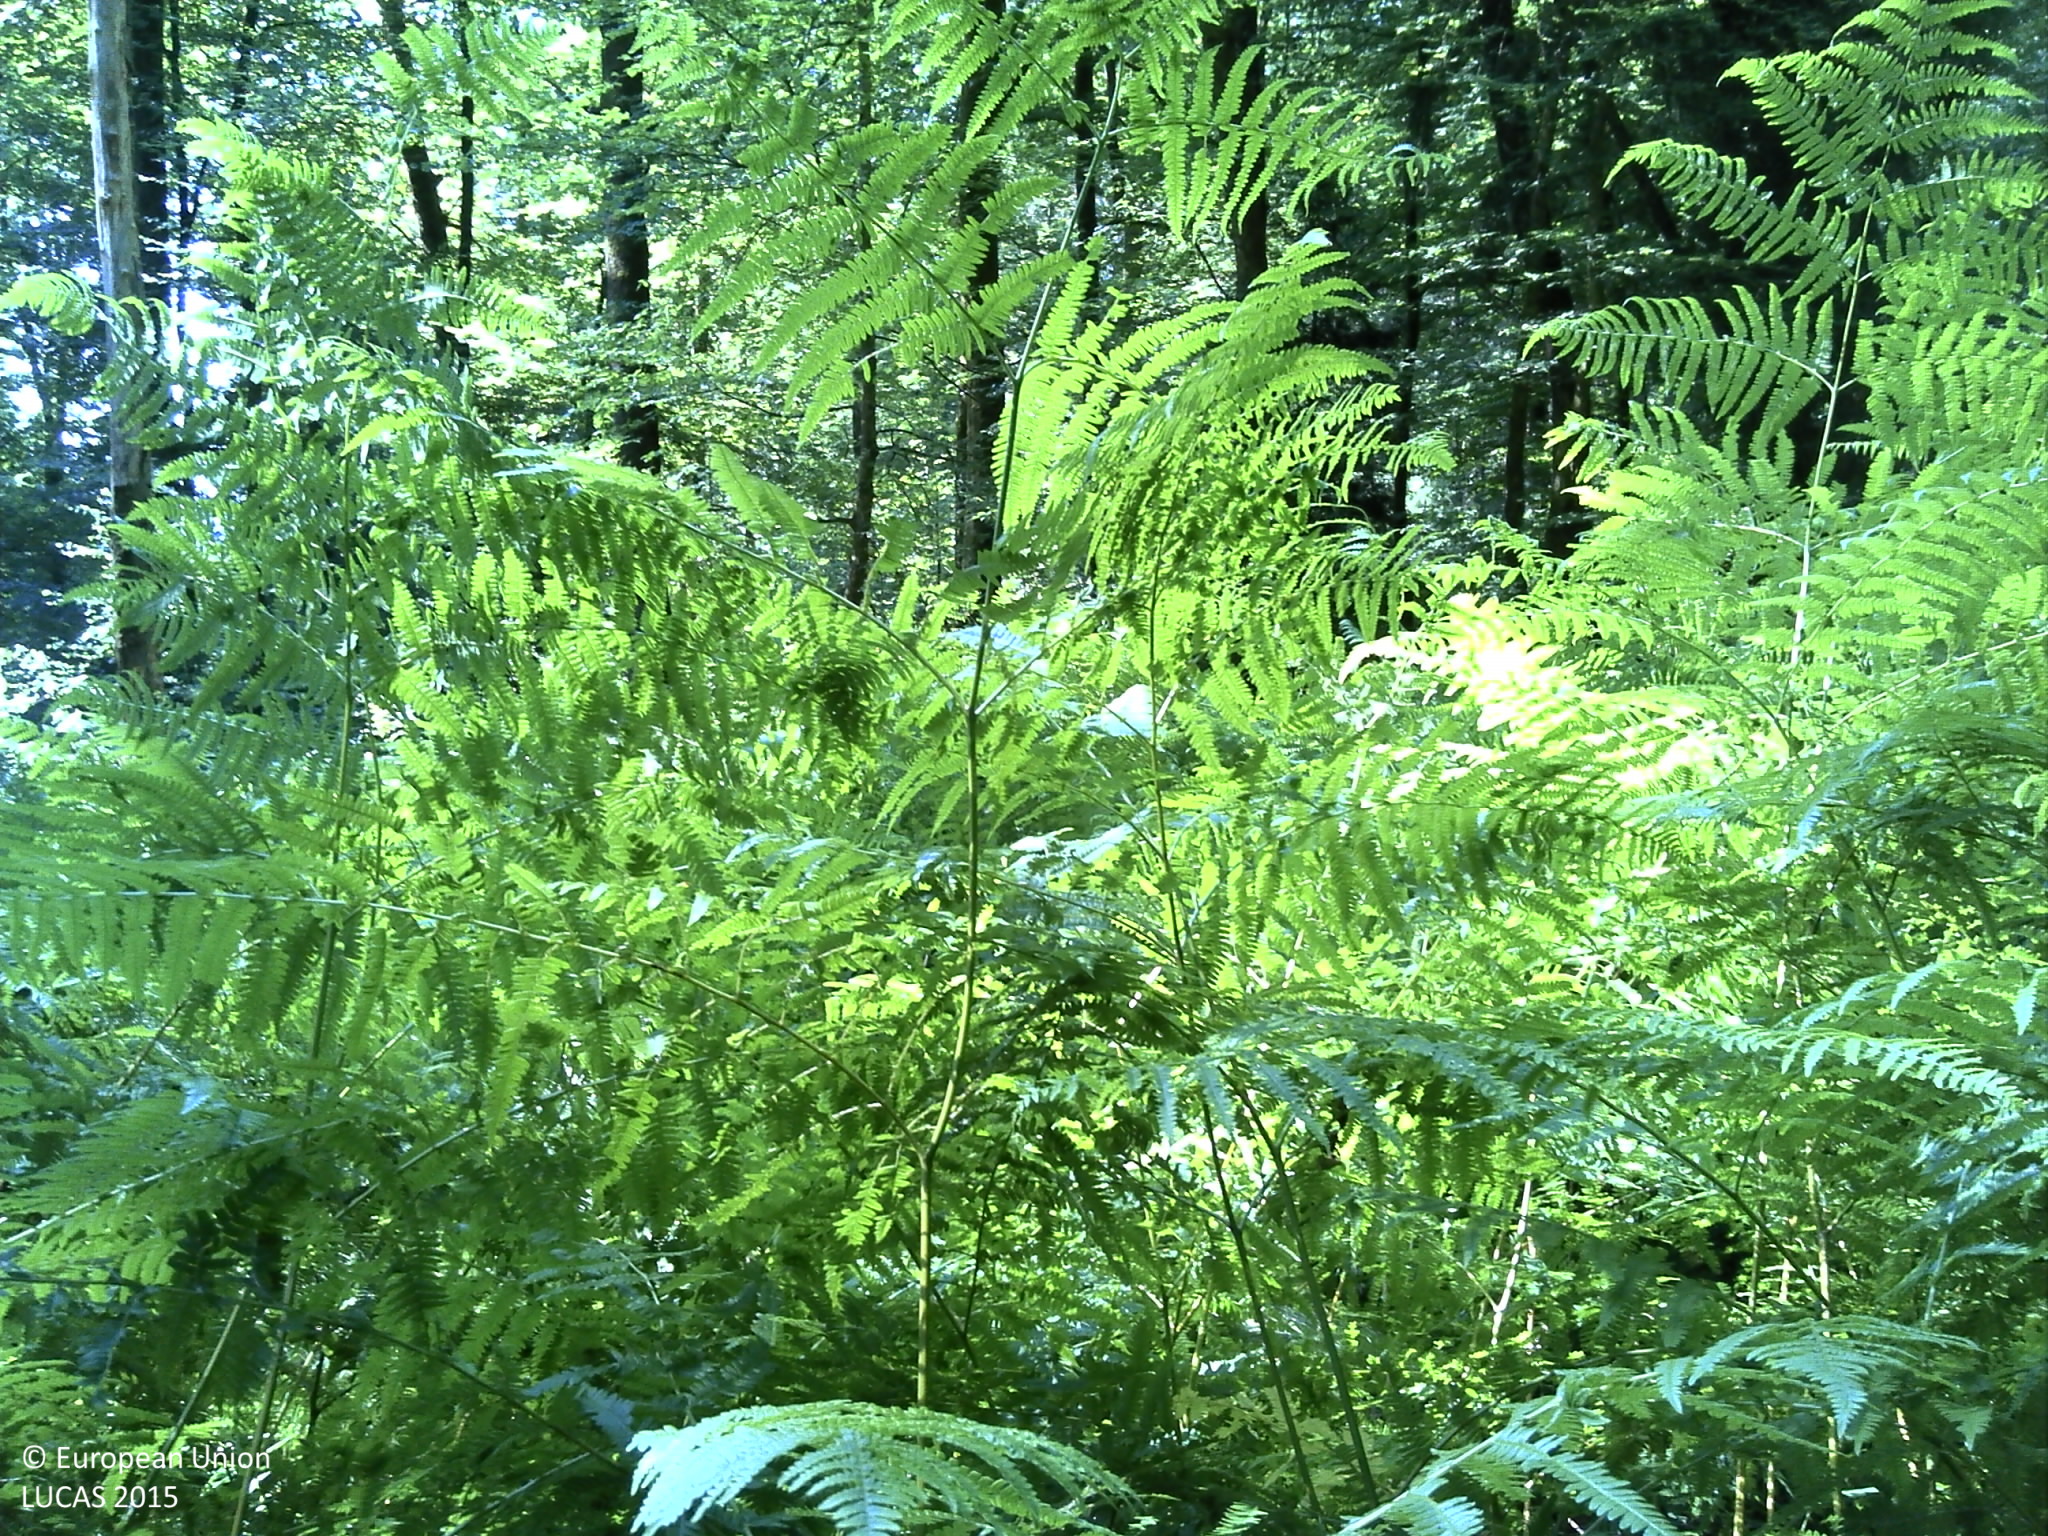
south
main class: Woodland
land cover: Broadleaved woodland
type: beech forest
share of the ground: > 75 %
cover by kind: broadleaved forest trees 100 %
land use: Forestry
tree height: > 5 m
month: July
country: FR
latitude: 48.1154
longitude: 6.0110
